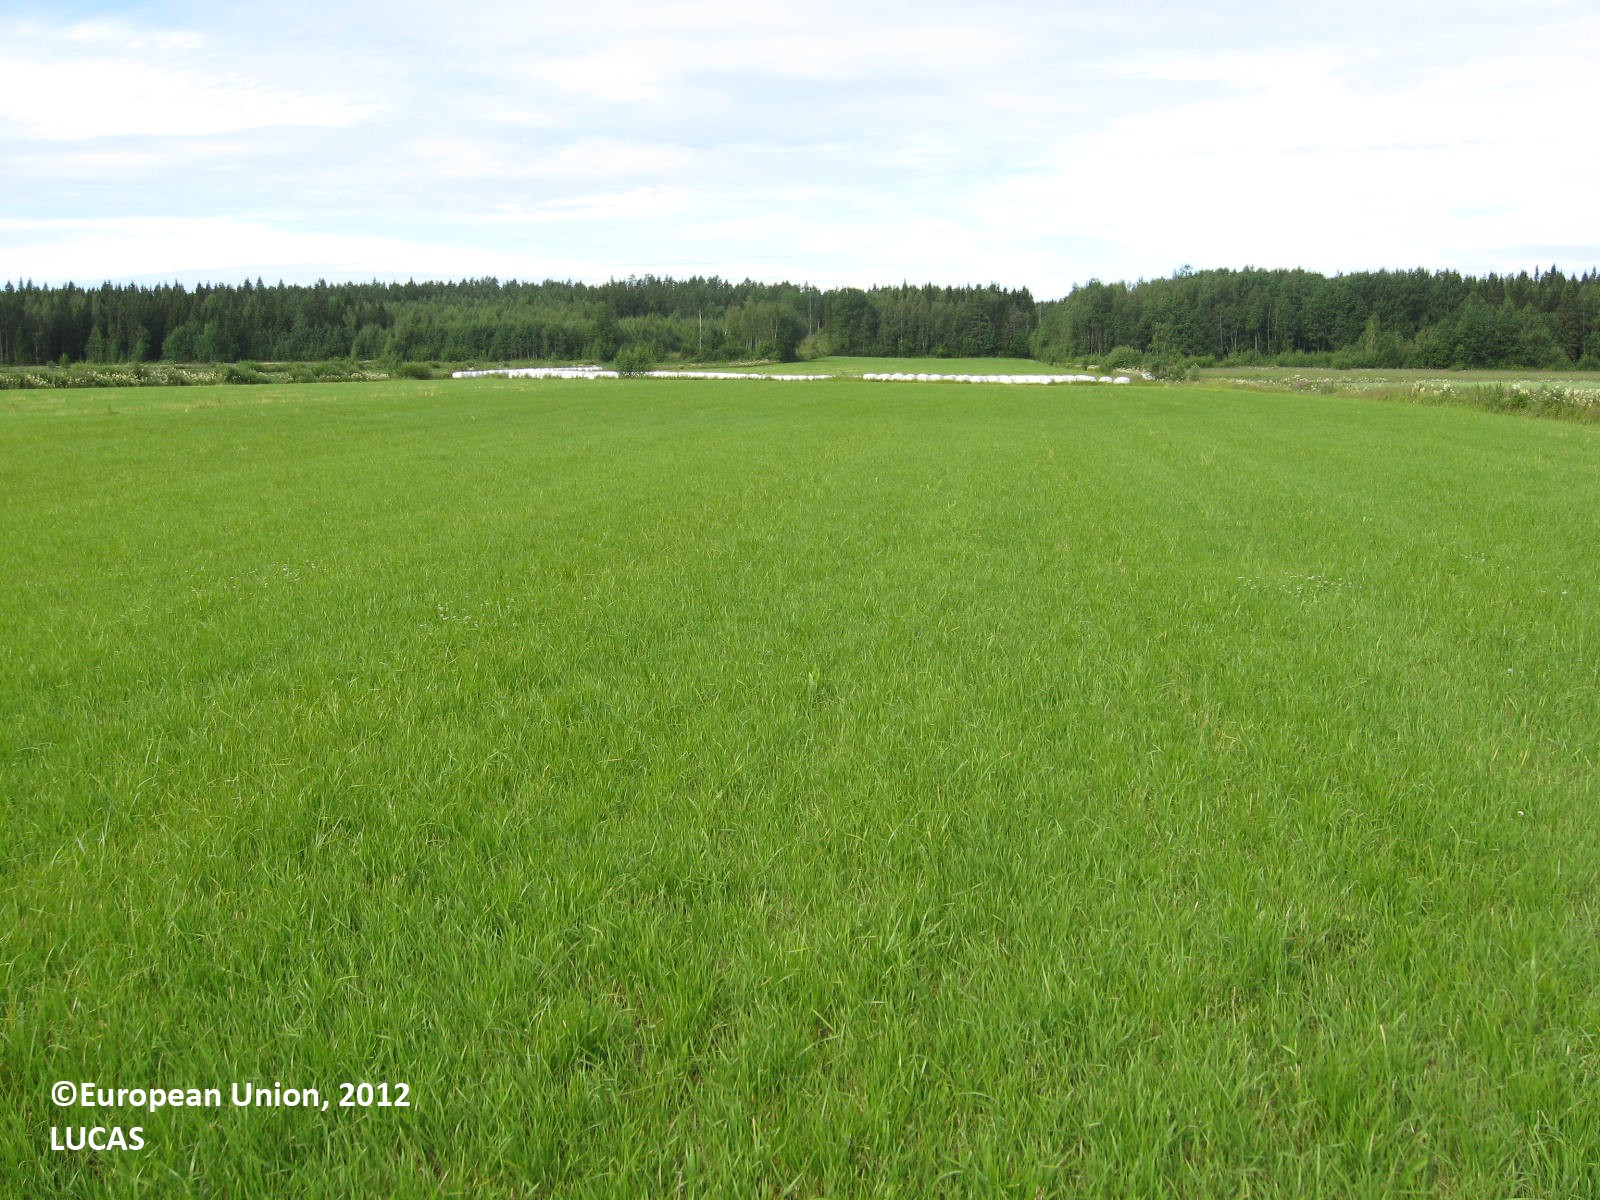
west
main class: Cropland
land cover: Temporary grasslands
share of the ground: > 75 %
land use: Agriculture (excluding fallow land and kitchen gardens)
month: July
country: FI
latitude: 62.2790
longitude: 21.5108
